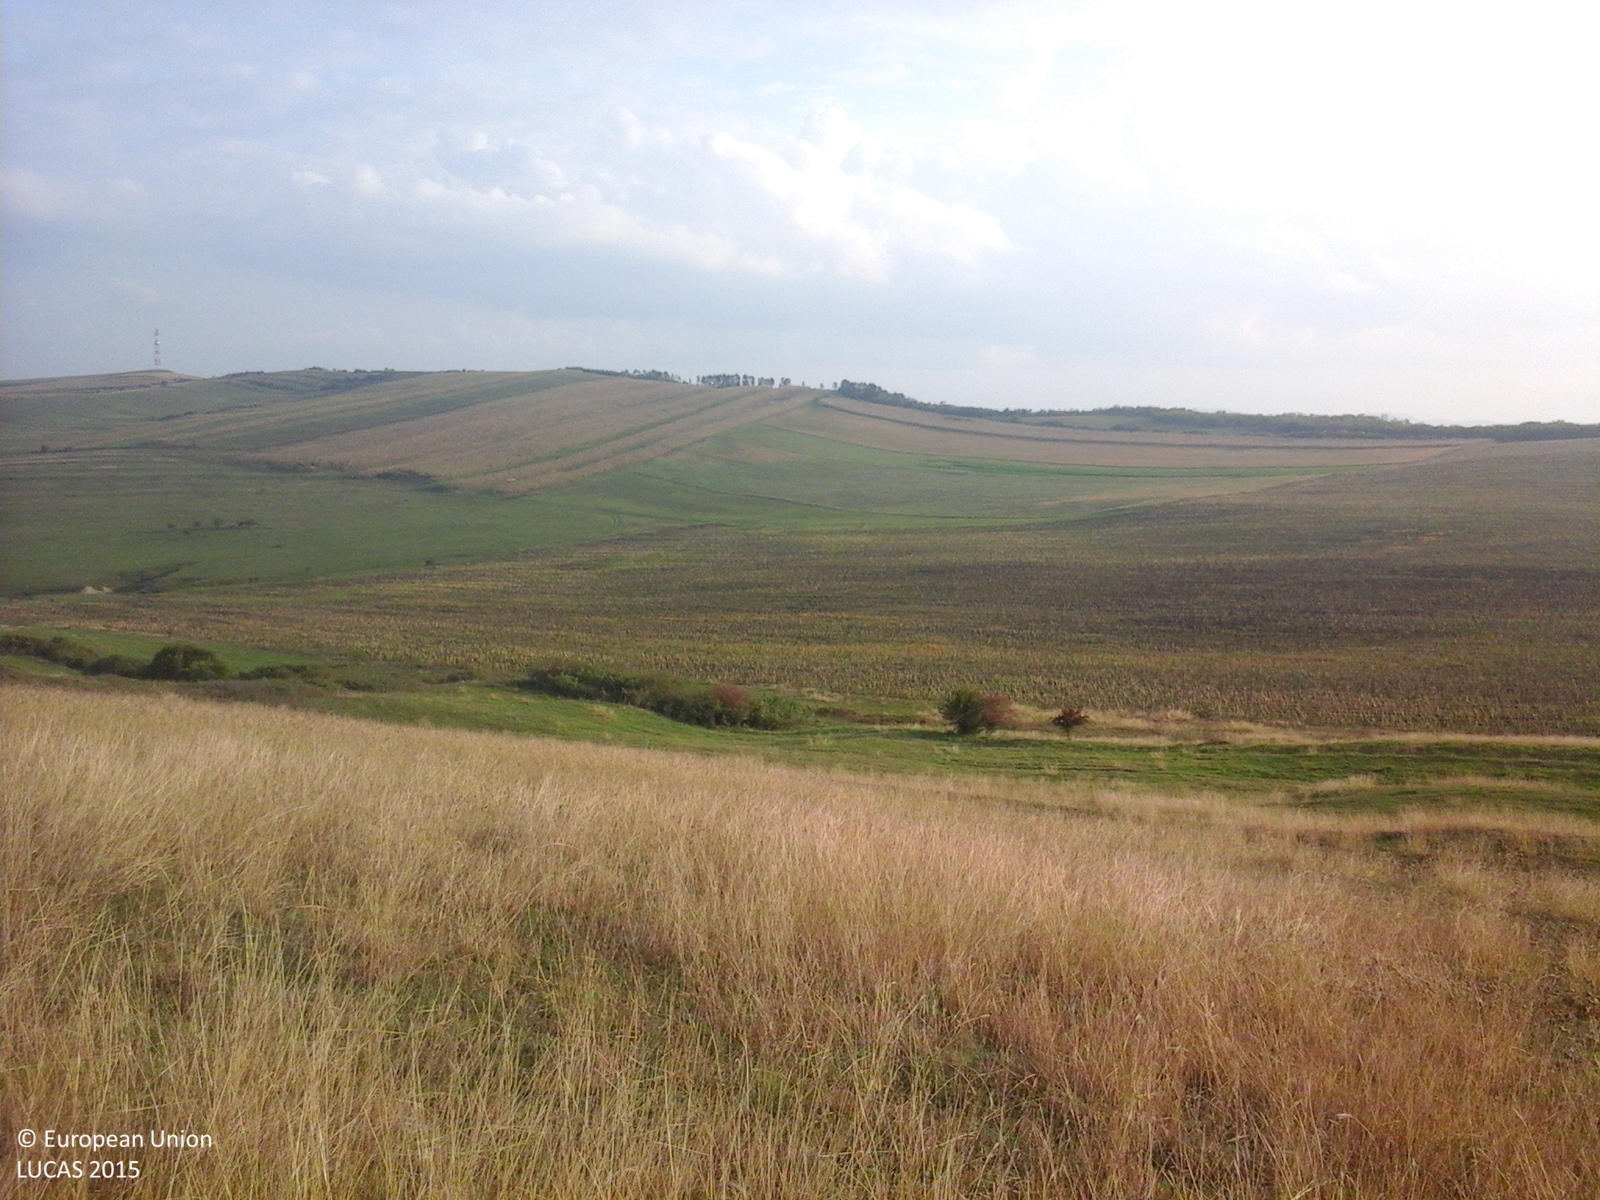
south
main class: Grassland
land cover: Grassland without tree/shrub cover
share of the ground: > 75 %
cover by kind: herbaceous plants 100 %
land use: Agriculture (excluding fallow land and kitchen gardens)
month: October
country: RO
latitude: 46.4876
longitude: 23.9765
